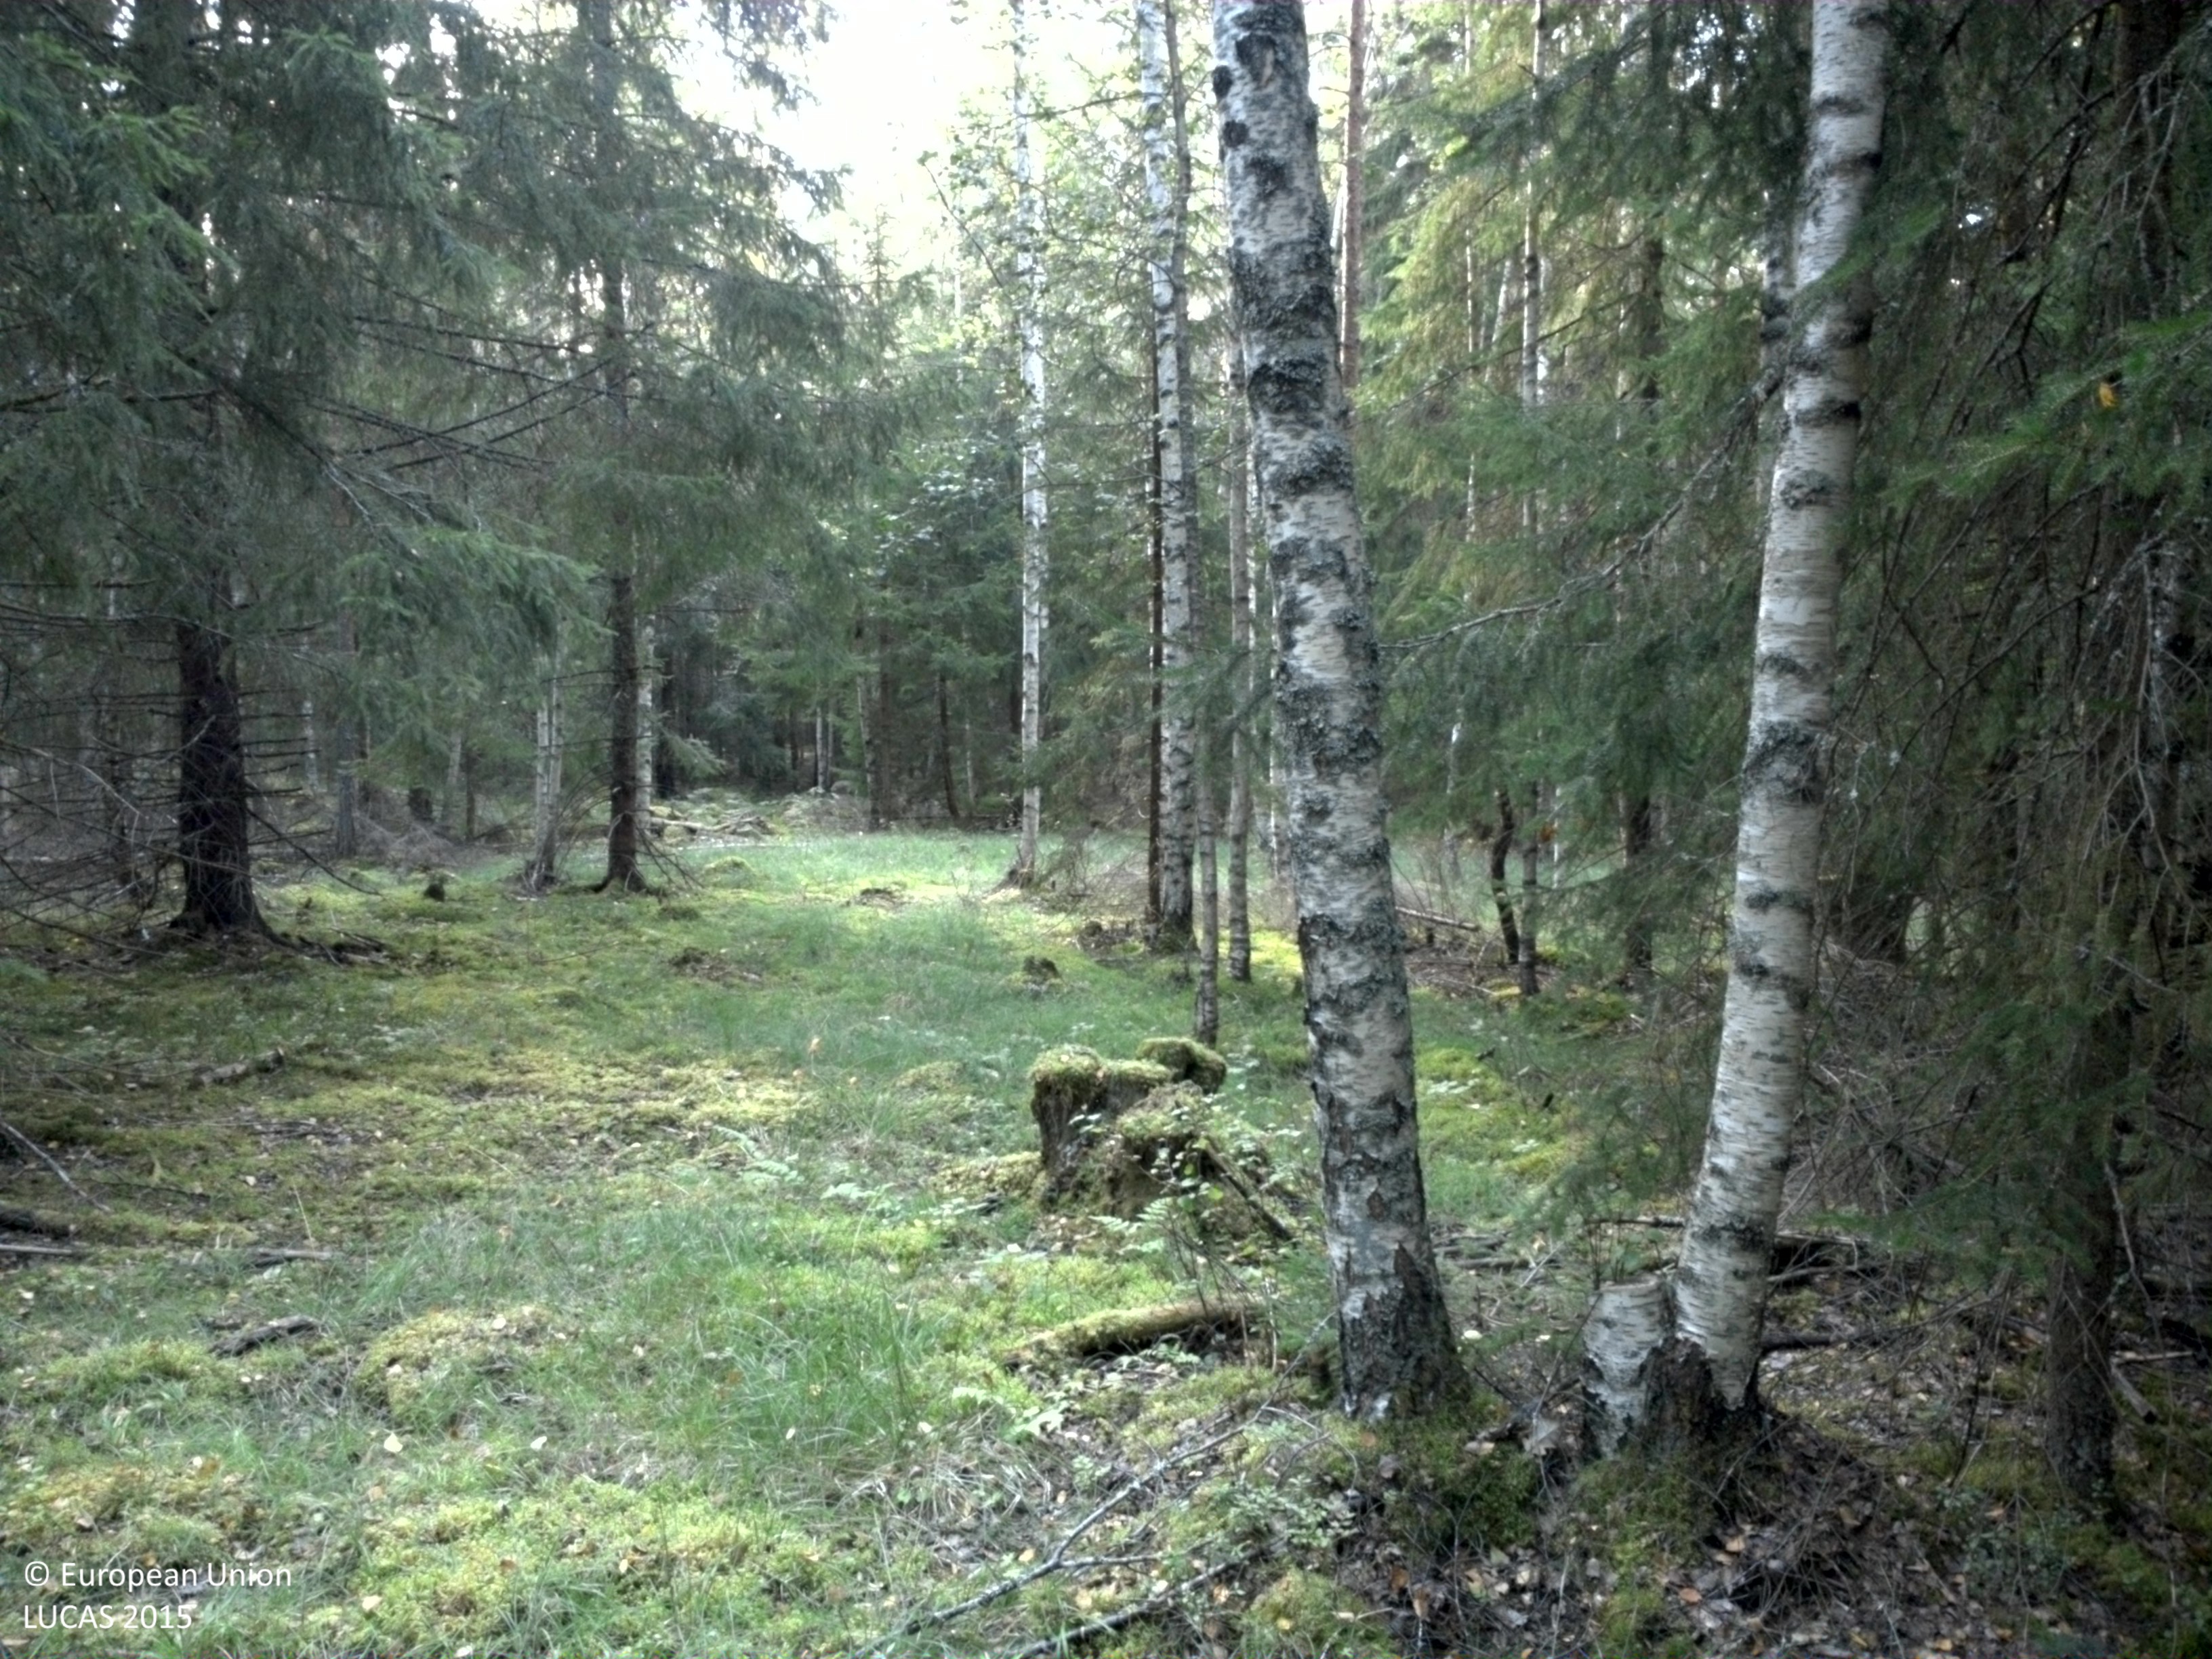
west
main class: Woodland
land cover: Spruce dominated mixed woodland
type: boreal forest
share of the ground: 50 - 75 %
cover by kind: coniferous forest trees 45 %, herbaceous plants 40 %, broadleaved forest trees 15 %
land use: Forestry
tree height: > 5 m
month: August
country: SE
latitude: 59.7078
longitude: 17.1918
